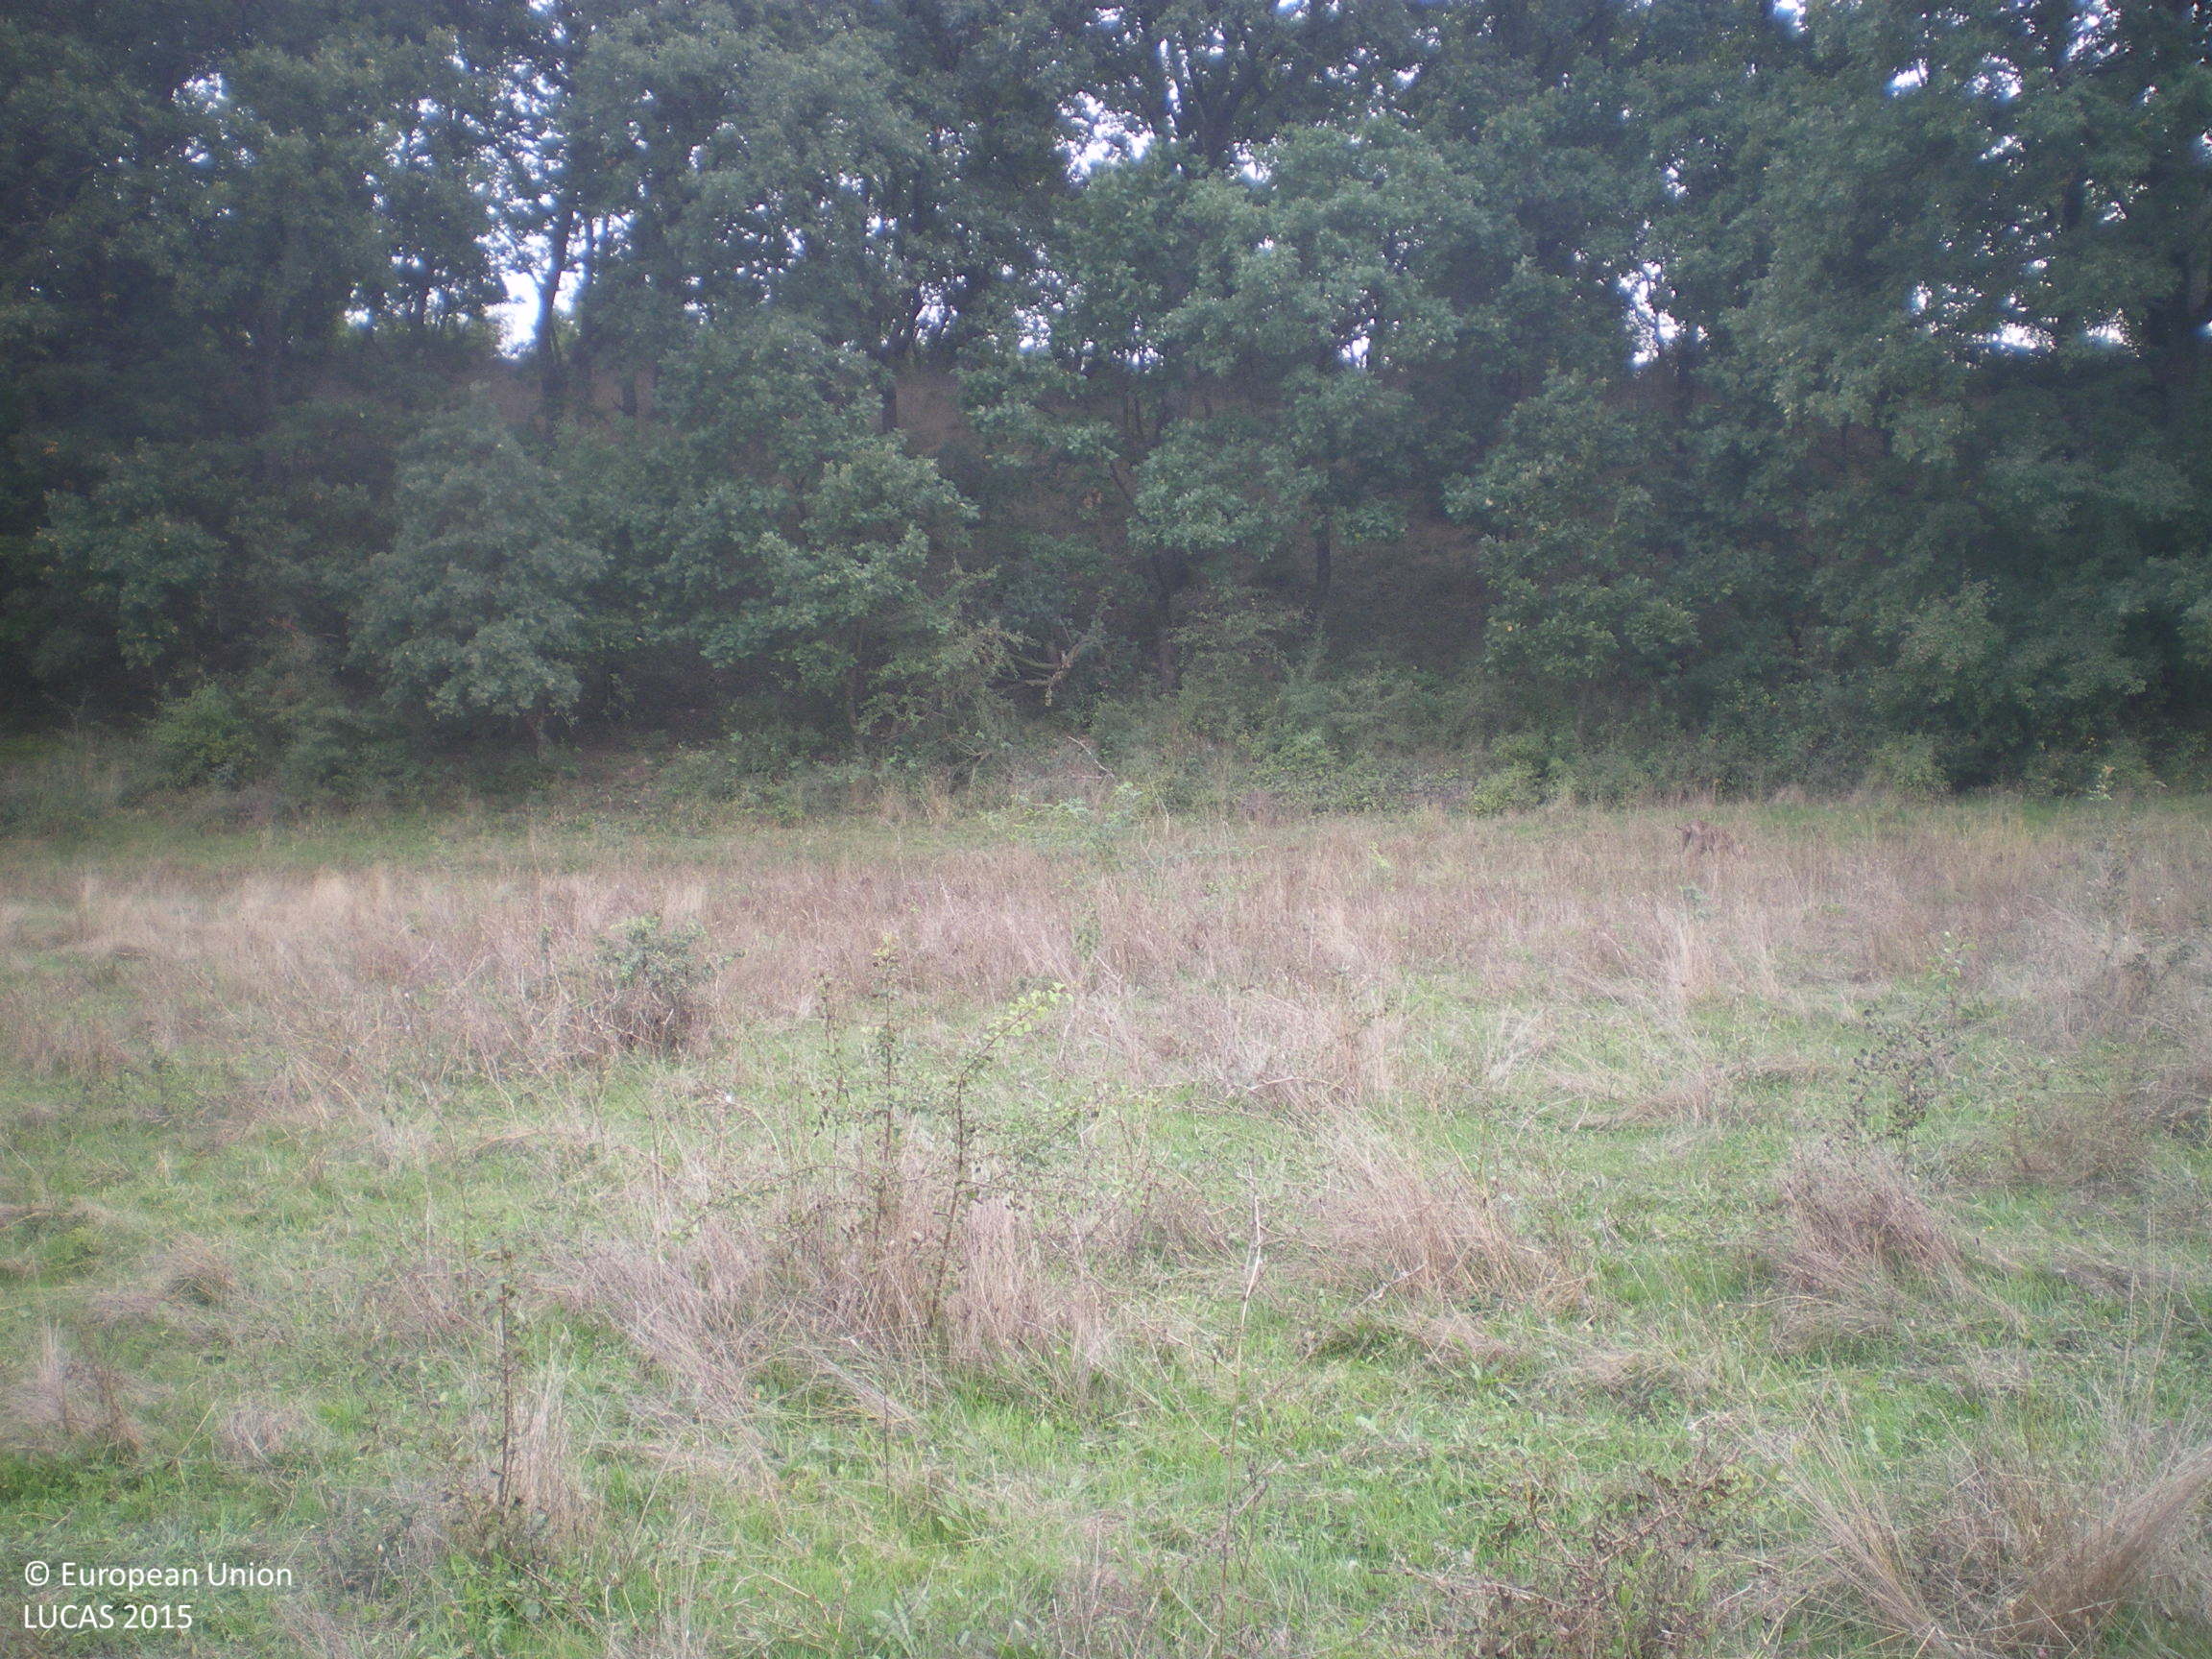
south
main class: Grassland
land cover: Grassland without tree/shrub cover
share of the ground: > 75 %
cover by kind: herbaceous plants 100 %
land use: Agriculture (excluding fallow land and kitchen gardens)
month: September
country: BG
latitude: 41.8467
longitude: 25.9082
